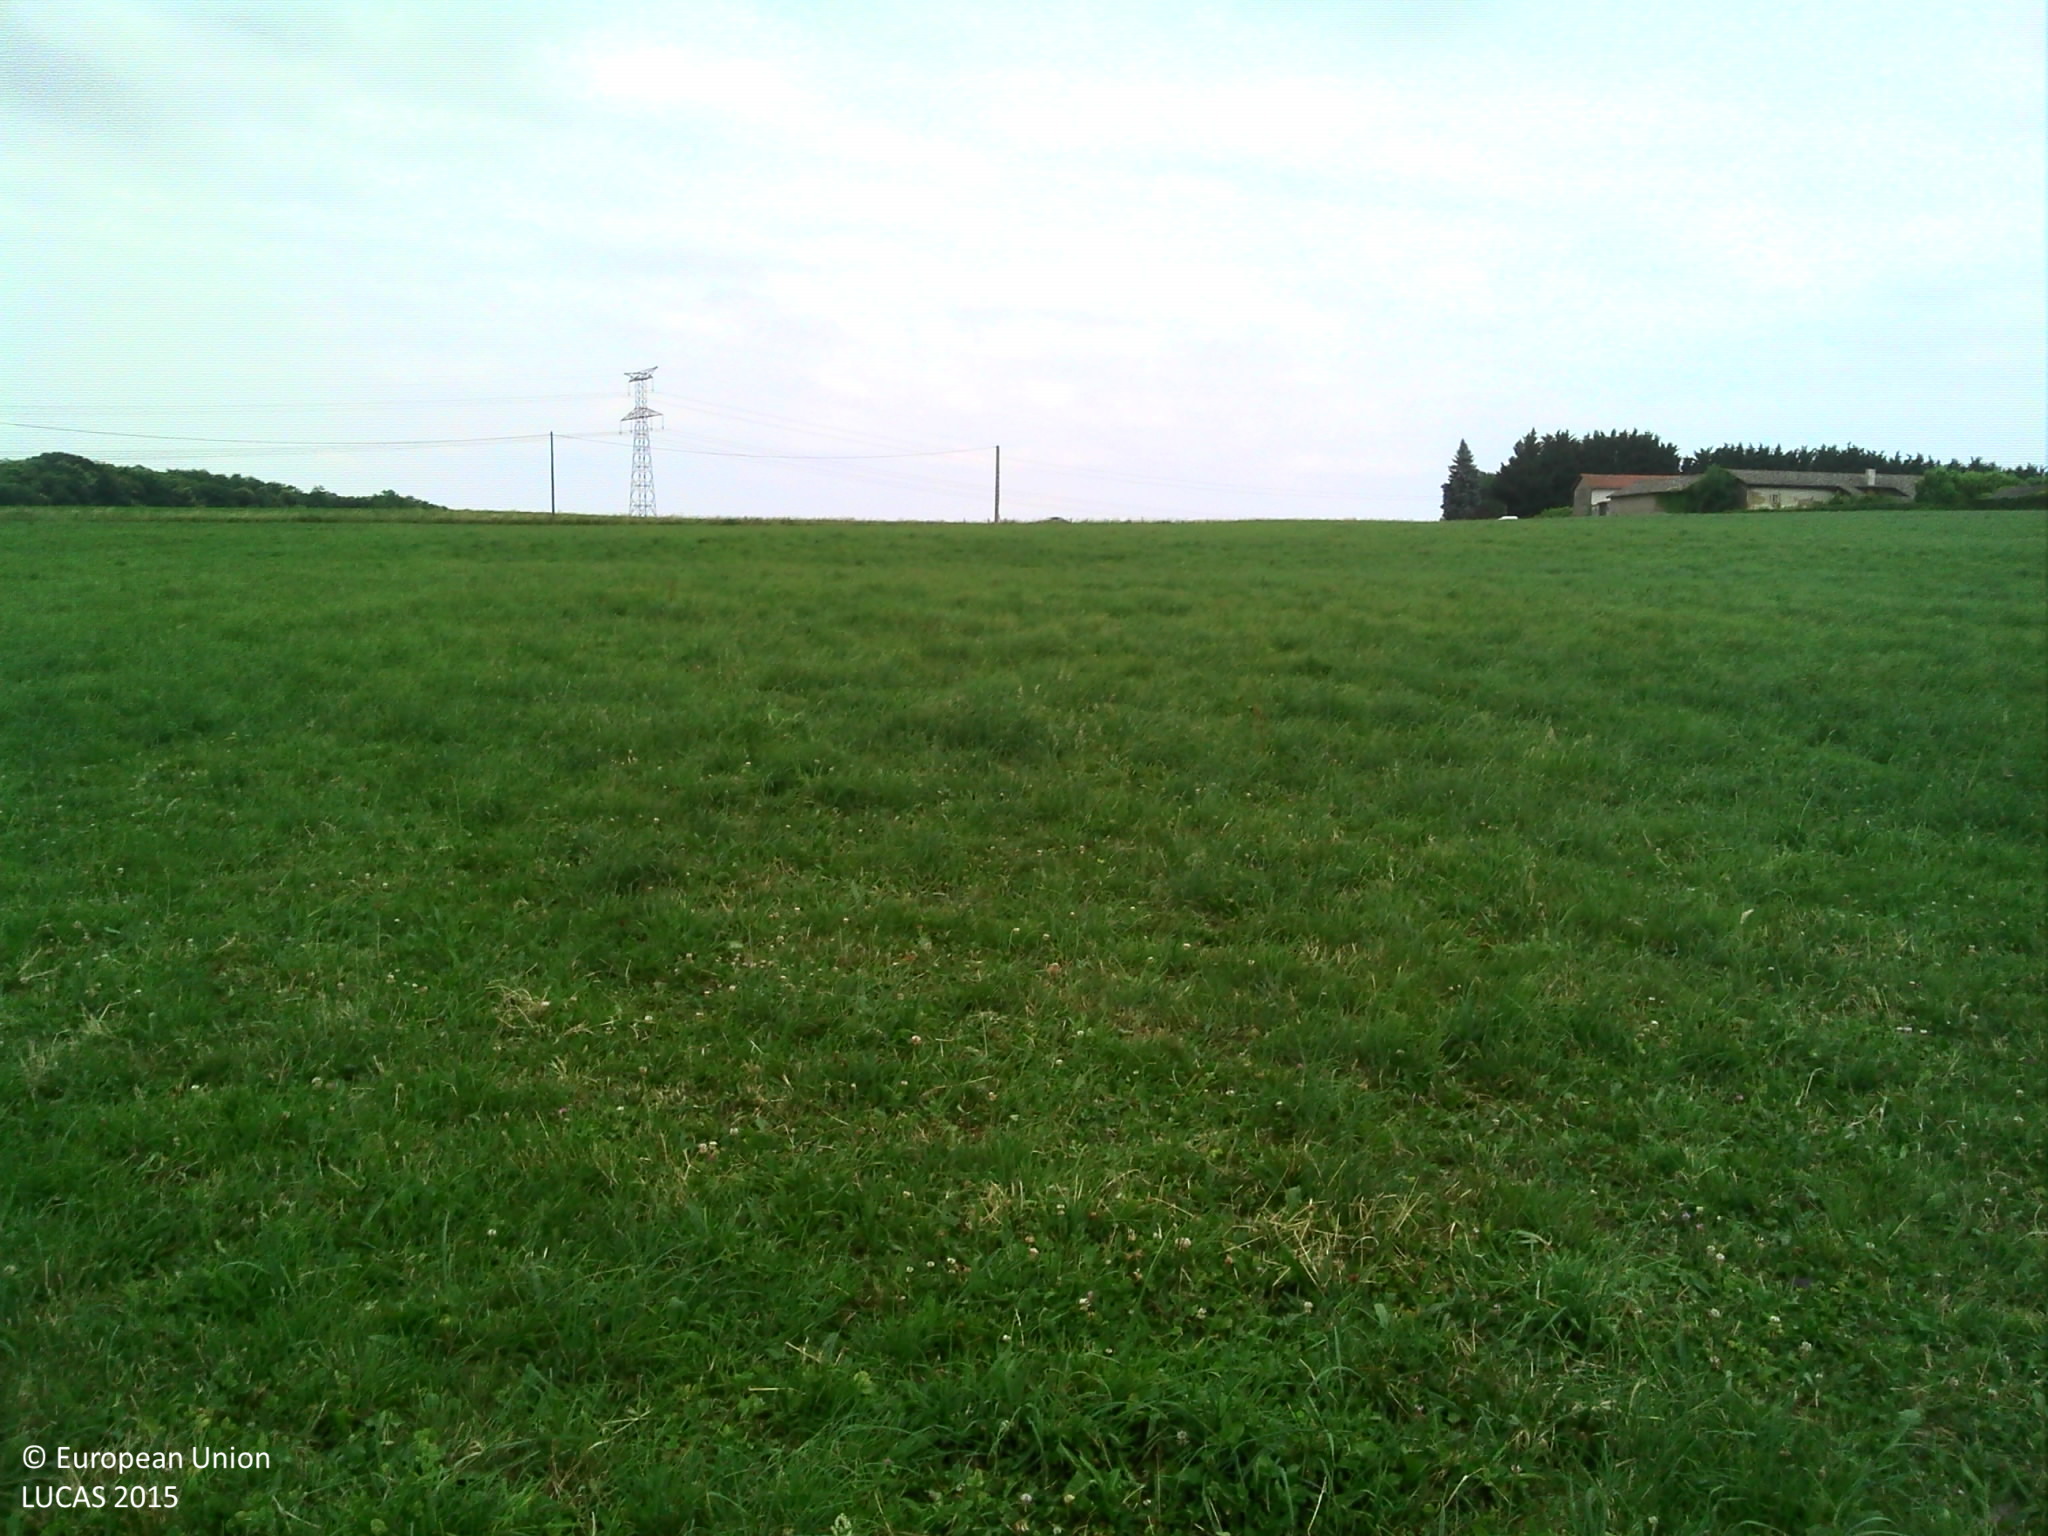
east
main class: Grassland
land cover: Grassland without tree/shrub cover
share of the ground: > 75 %
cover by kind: herbaceous plants 100 %
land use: Agriculture (excluding fallow land and kitchen gardens)
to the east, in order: Grassland without tree/shrub cover; Electric lines; Fences; Grass margins; Paved roads, cycling and walking lanes; Ditches and canals; Maize
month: June
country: FR
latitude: 46.0837
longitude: 4.8689
